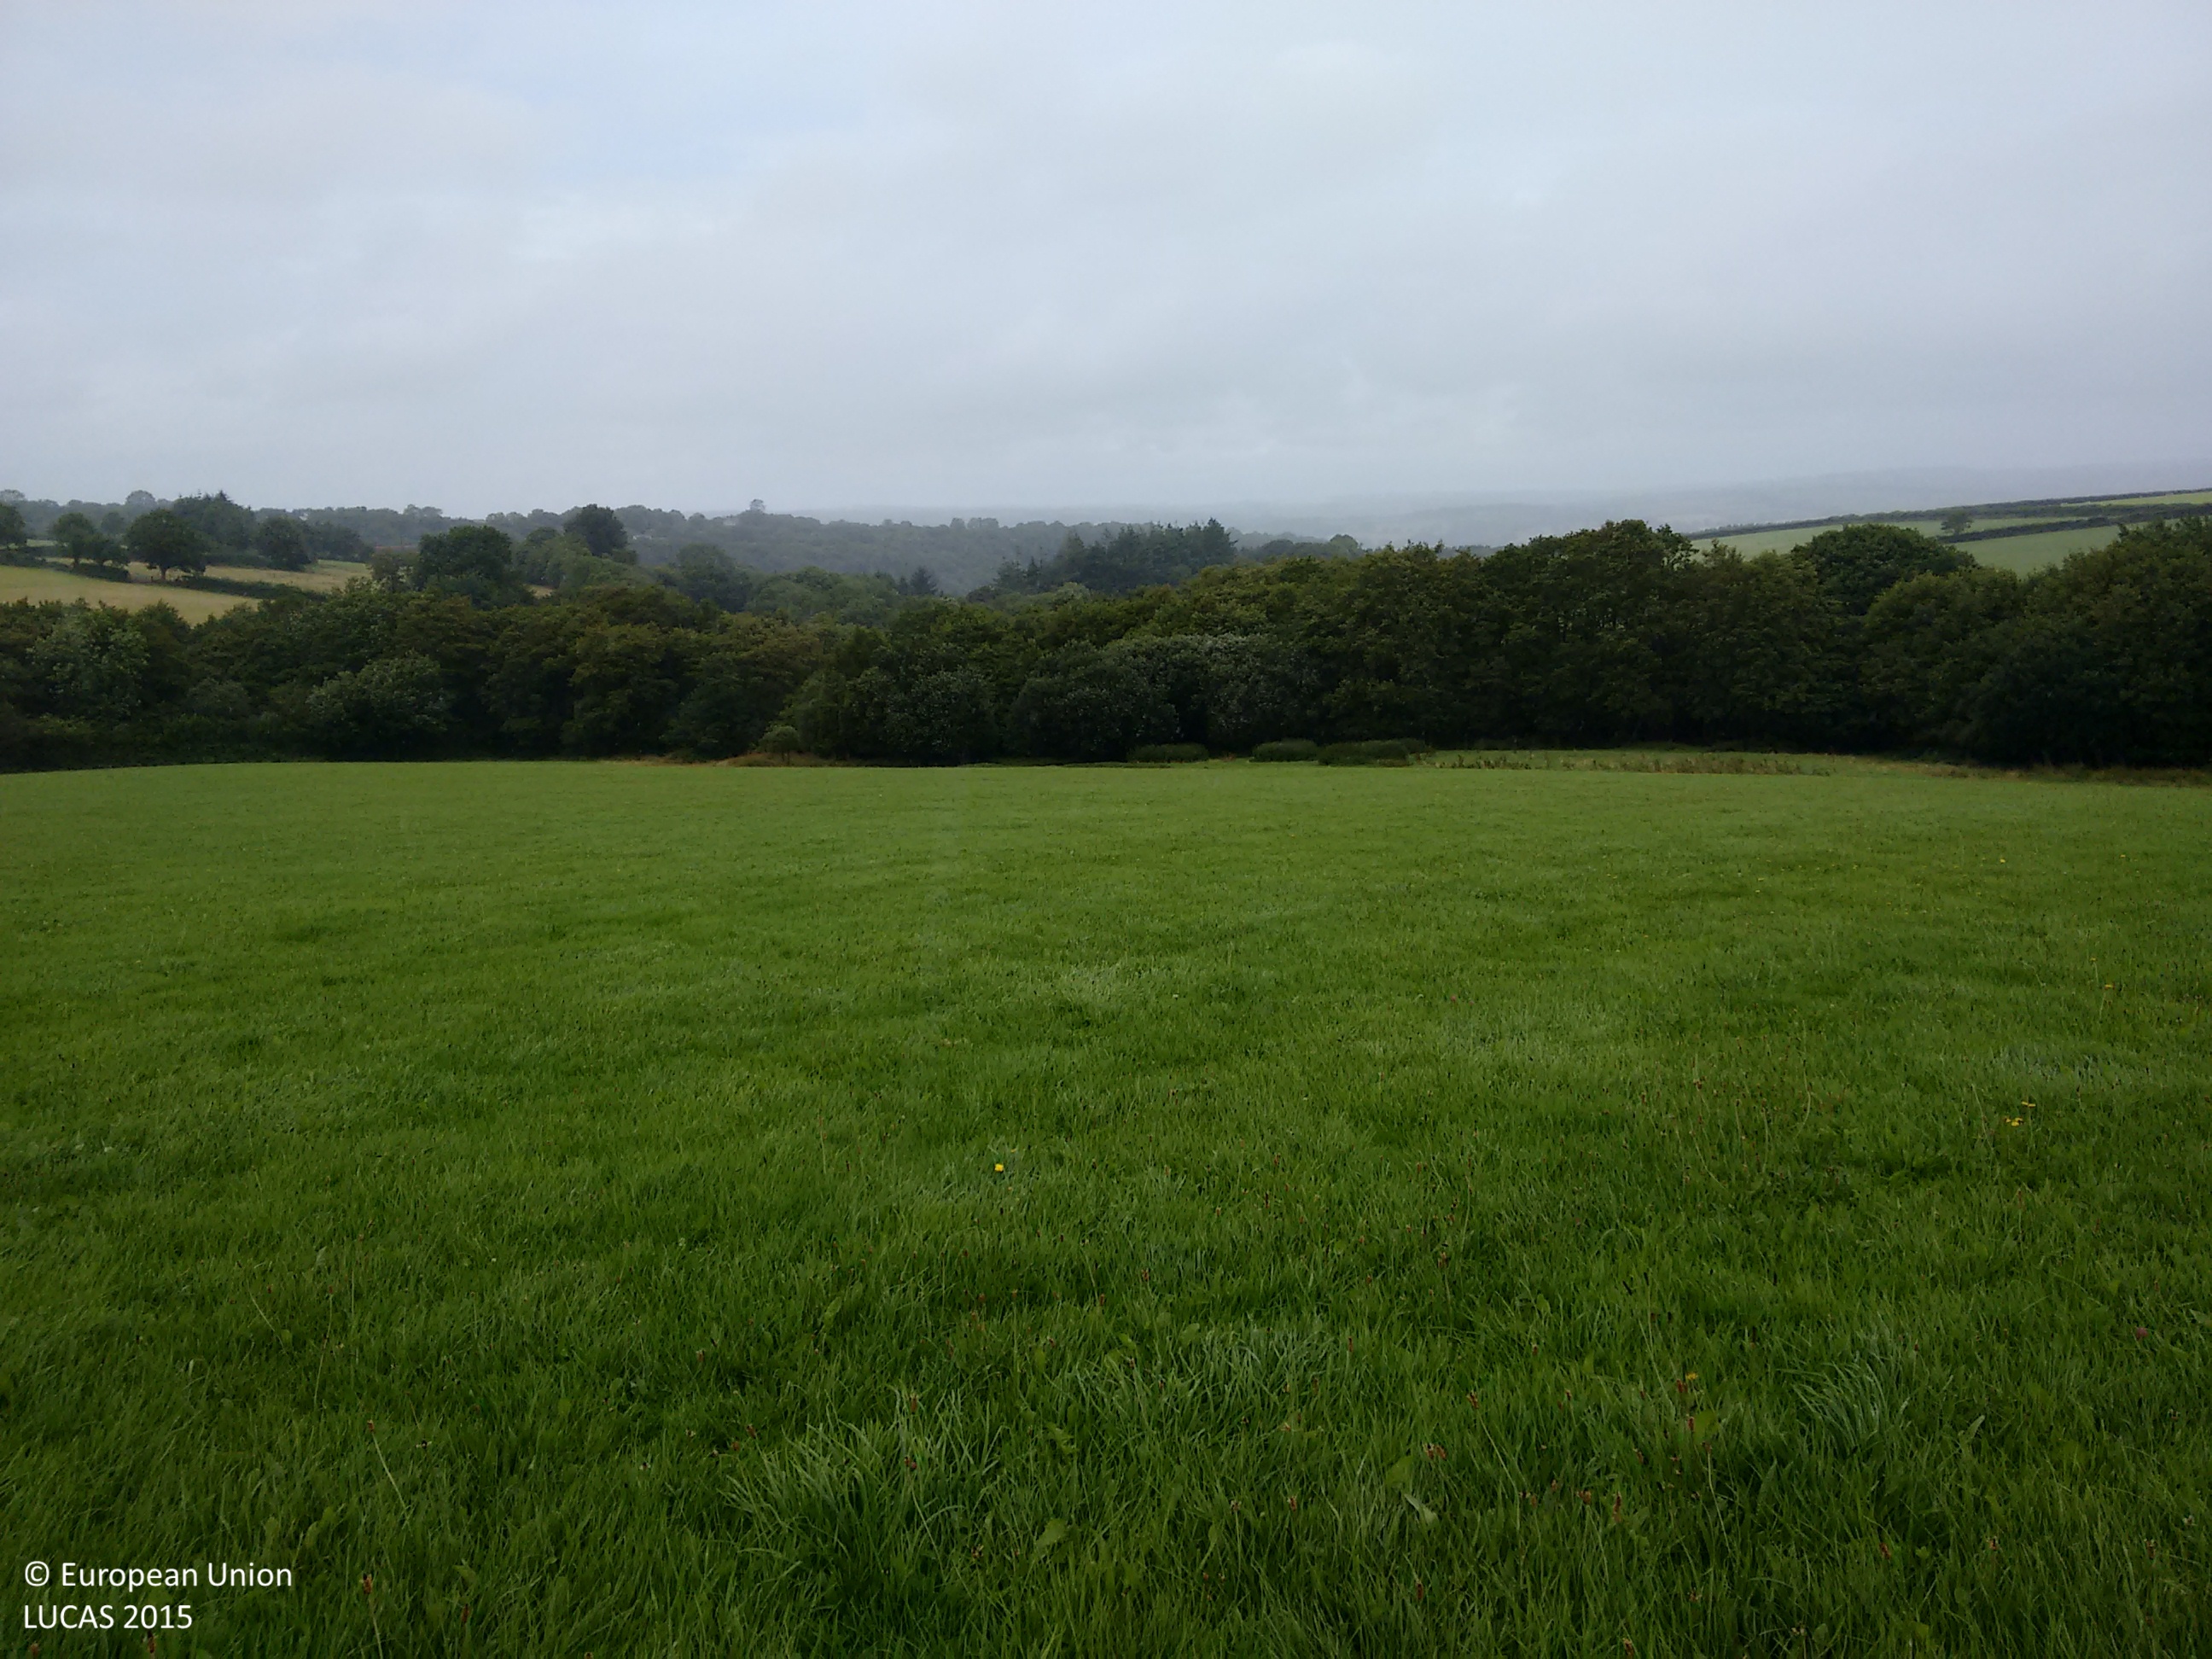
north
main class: Grassland
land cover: Grassland without tree/shrub cover
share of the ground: > 75 %
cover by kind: herbaceous plants 100 %
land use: Agriculture (excluding fallow land and kitchen gardens)
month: August
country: GB
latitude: 52.0162
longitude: -4.4570
